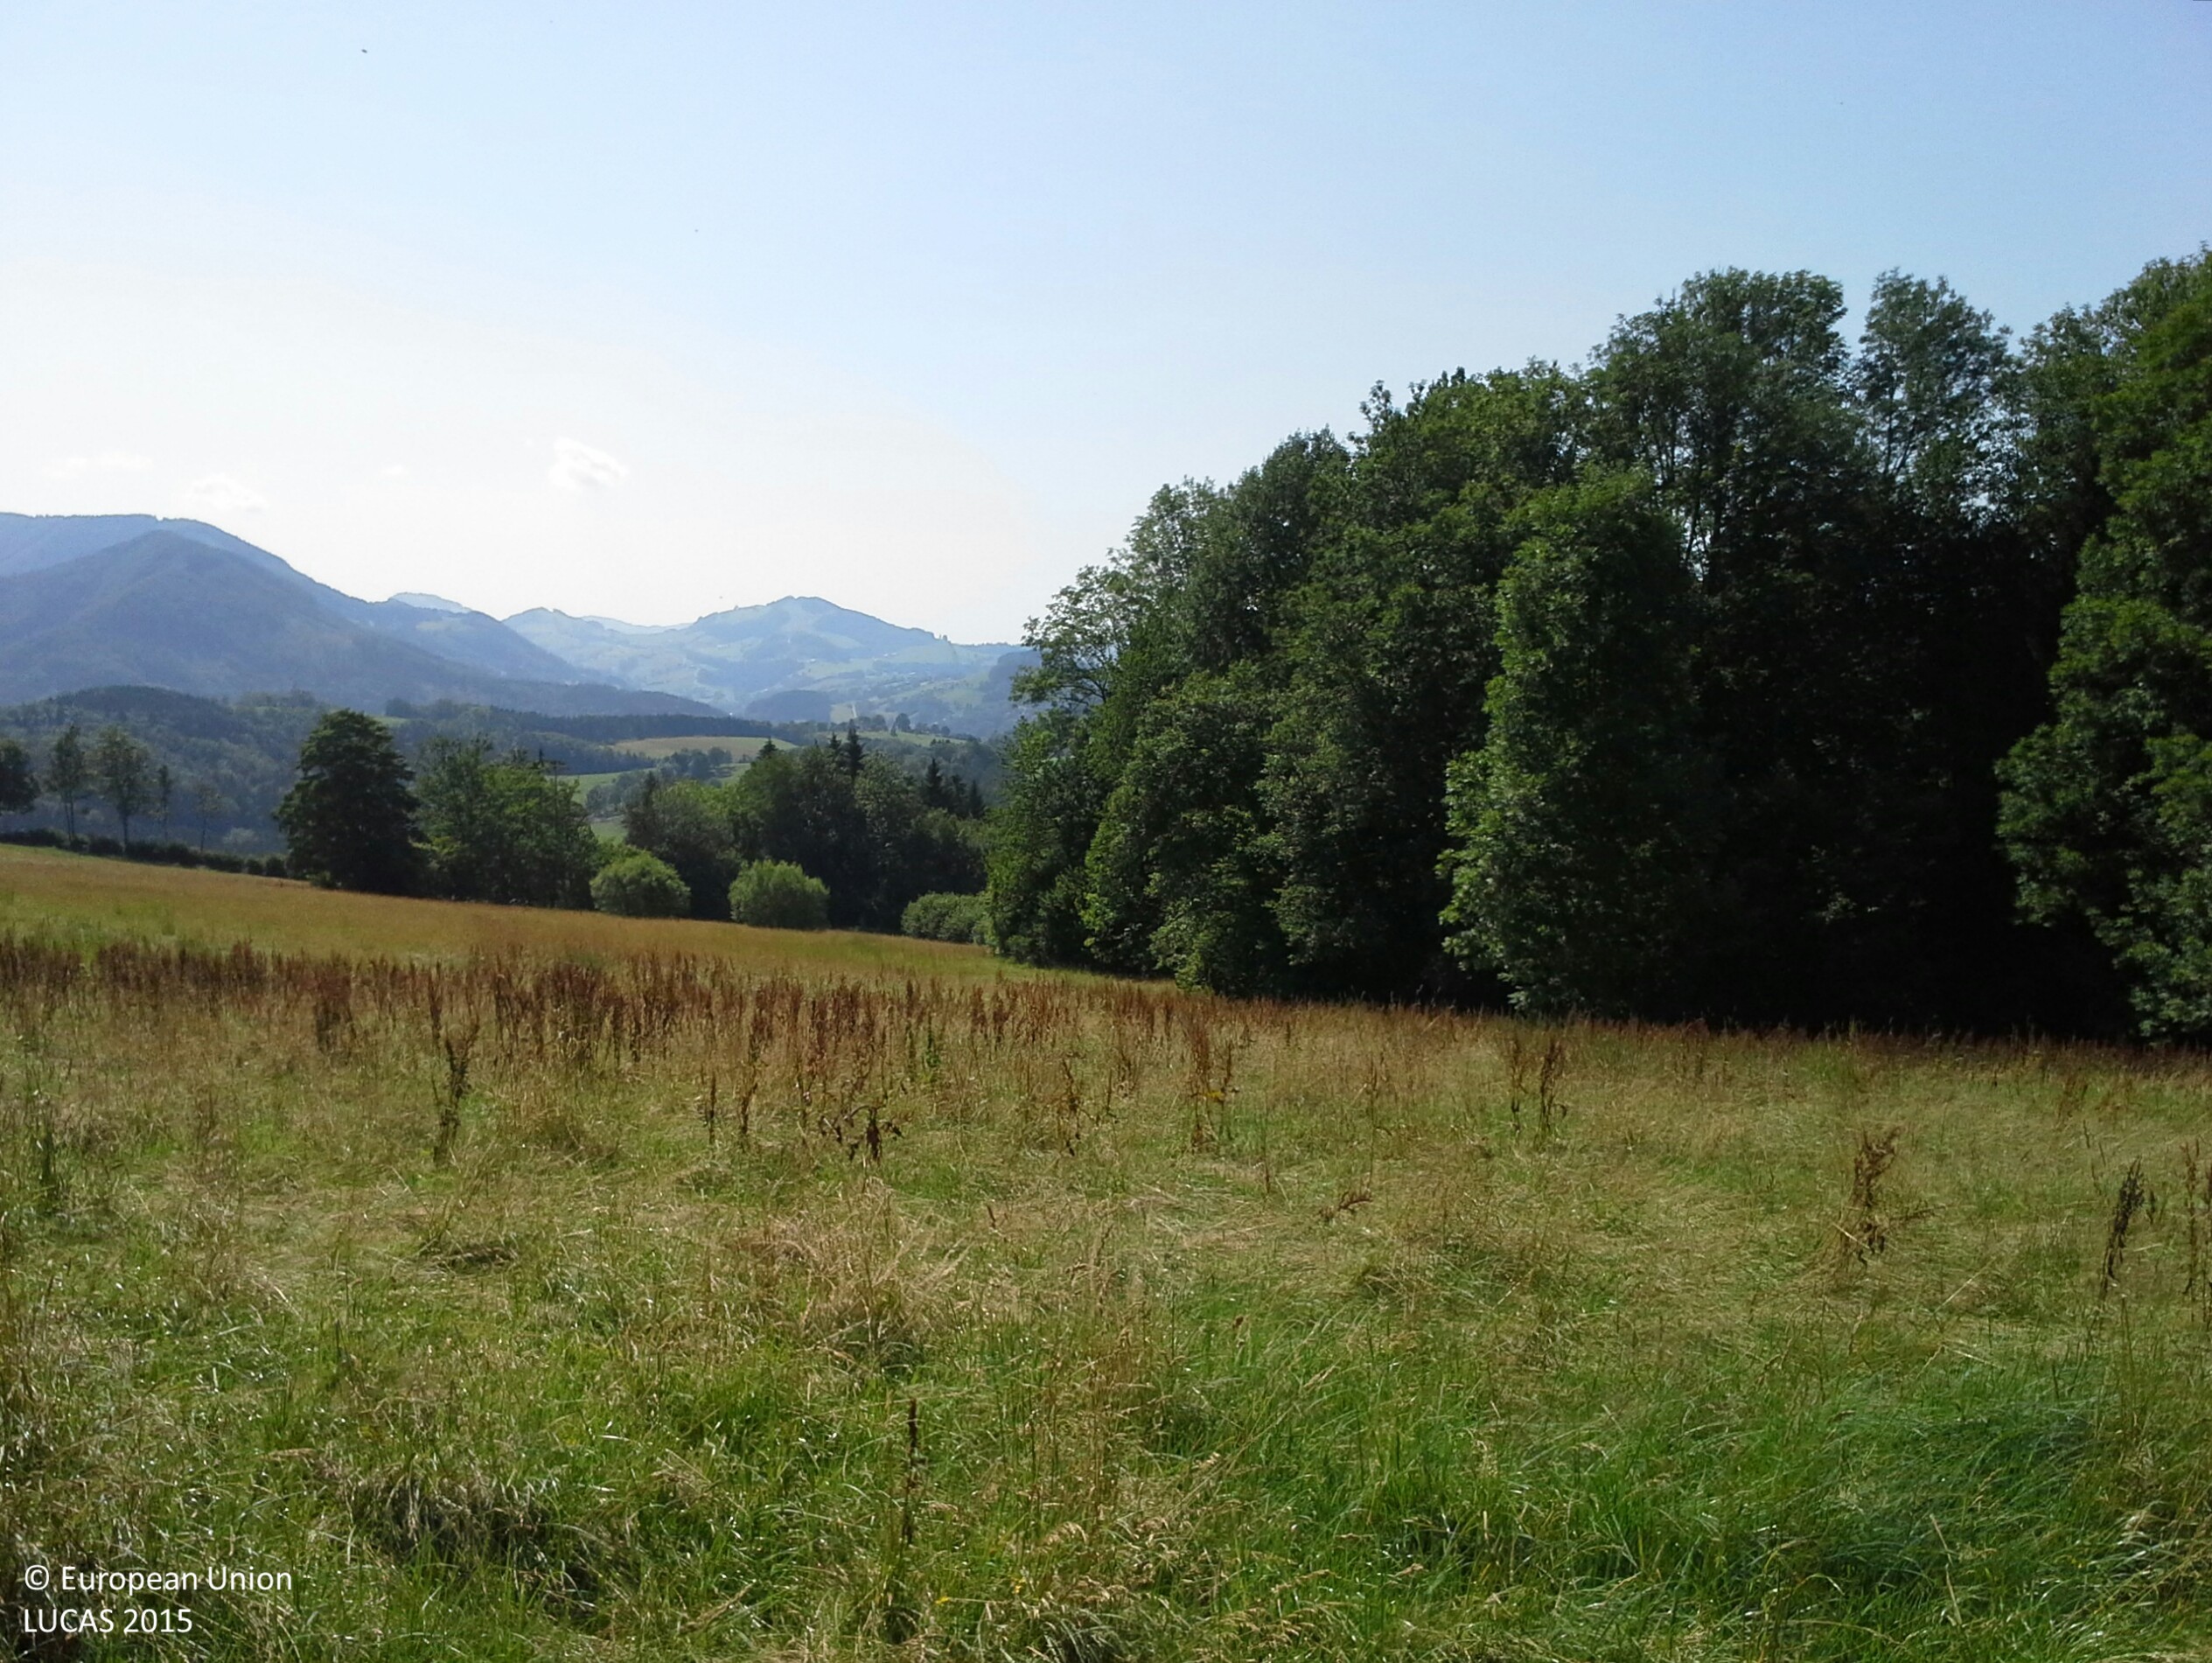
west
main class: Grassland
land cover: Grassland without tree/shrub cover
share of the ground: > 75 %
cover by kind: herbaceous plants 100 %
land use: Agriculture (excluding fallow land and kitchen gardens)
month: July
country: AT
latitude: 47.9553
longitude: 14.8346
